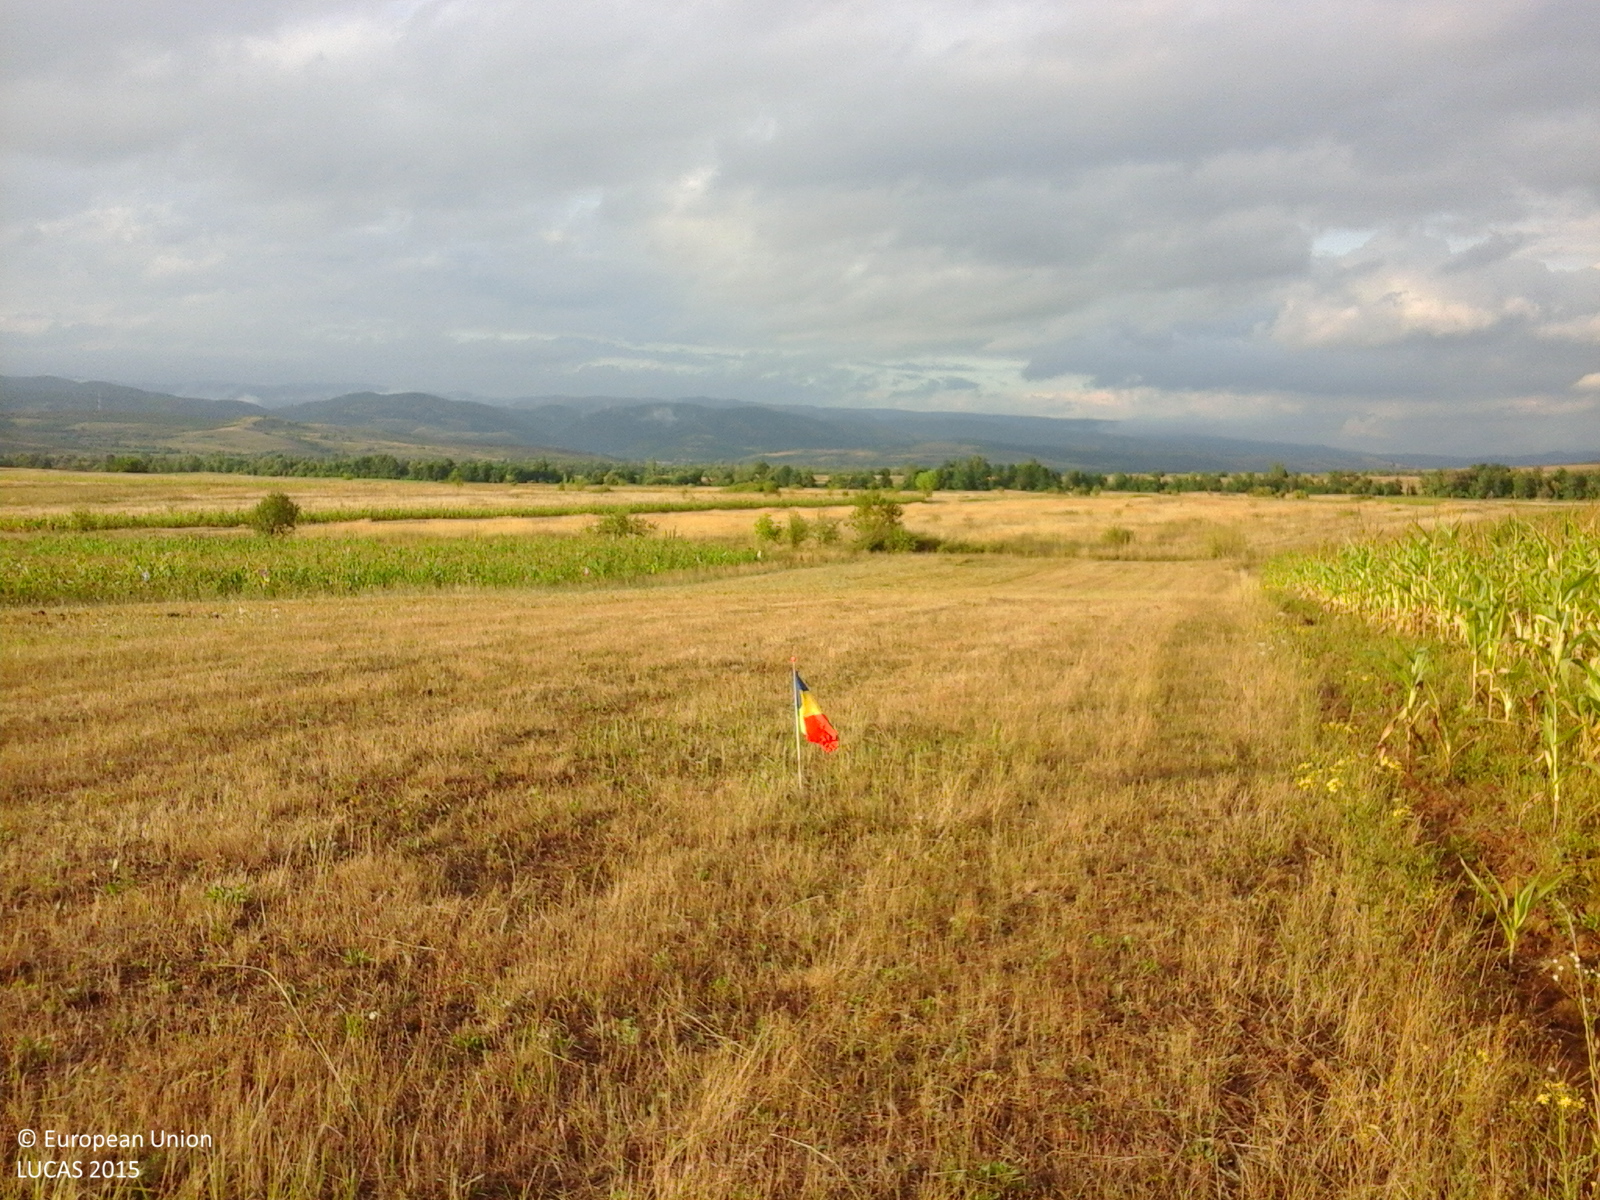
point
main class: Grassland
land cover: Grassland without tree/shrub cover
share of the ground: > 75 %
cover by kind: herbaceous plants 100 %
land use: Agriculture (excluding fallow land and kitchen gardens)
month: August
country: RO
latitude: 44.8752
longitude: 21.9709
